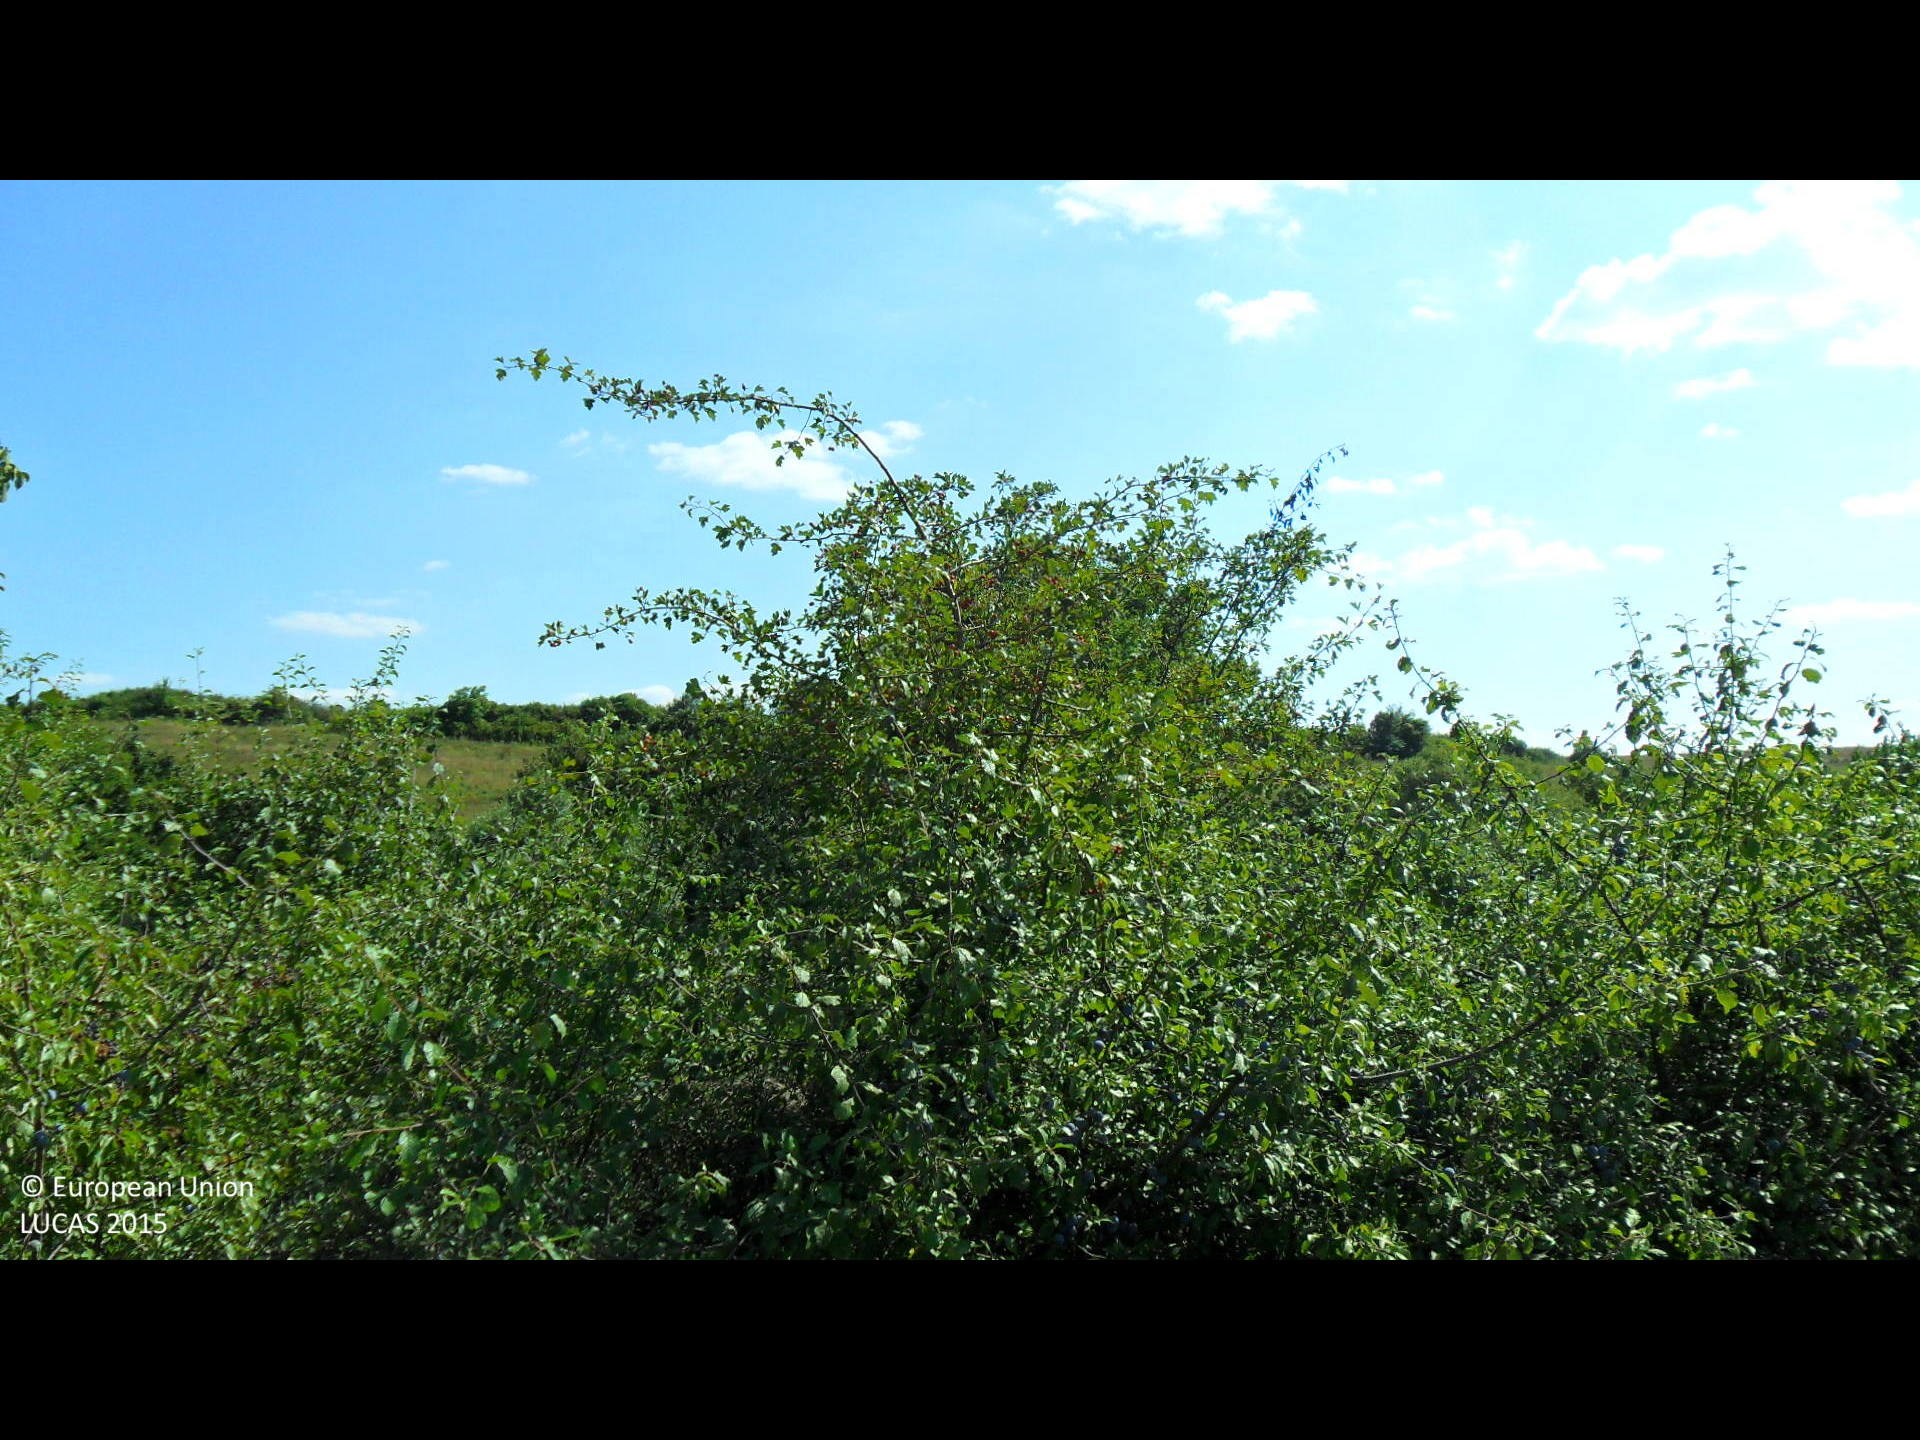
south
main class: Cropland
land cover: Sunflower
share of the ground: > 75 %
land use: Agriculture (excluding fallow land and kitchen gardens)
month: August
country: BG
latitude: 43.4650
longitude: 26.3545
